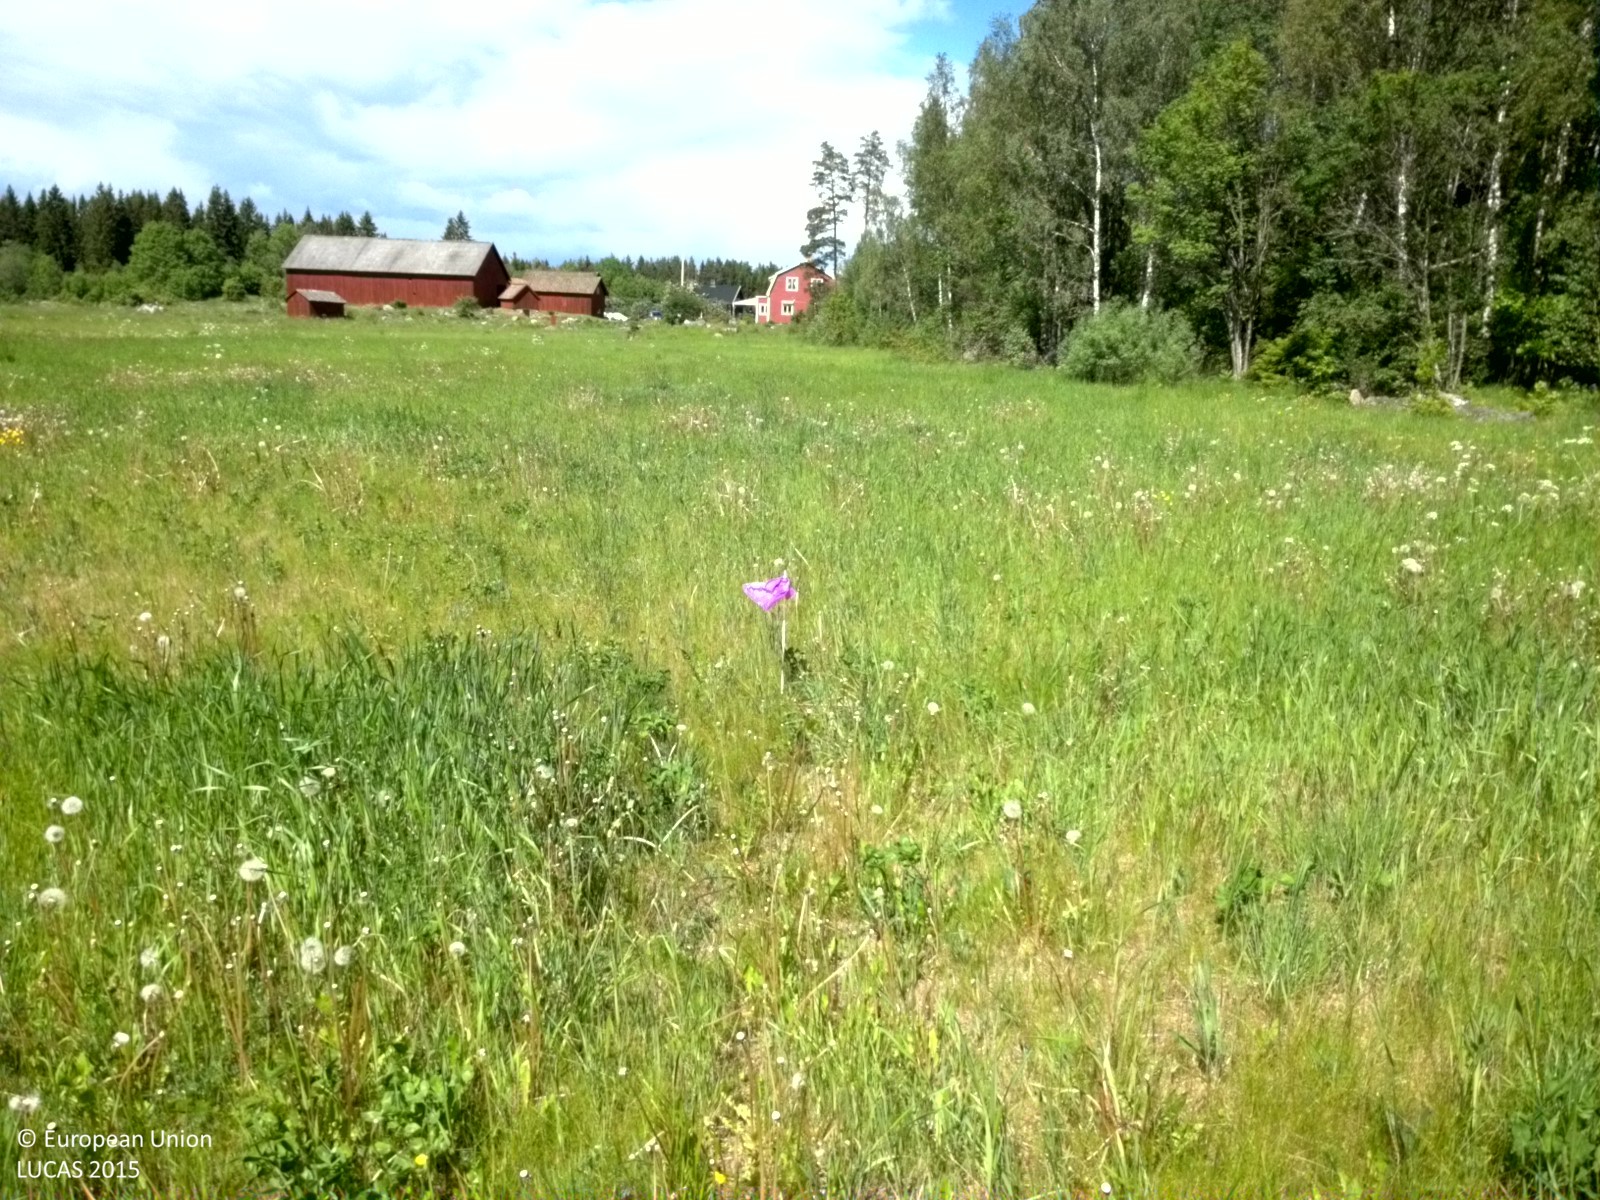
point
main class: Grassland
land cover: Grassland without tree/shrub cover
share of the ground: > 75 %
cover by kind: herbaceous plants 100 %
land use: Agriculture (excluding fallow land and kitchen gardens)
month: June
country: SE
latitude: 60.2335
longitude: 17.8484
